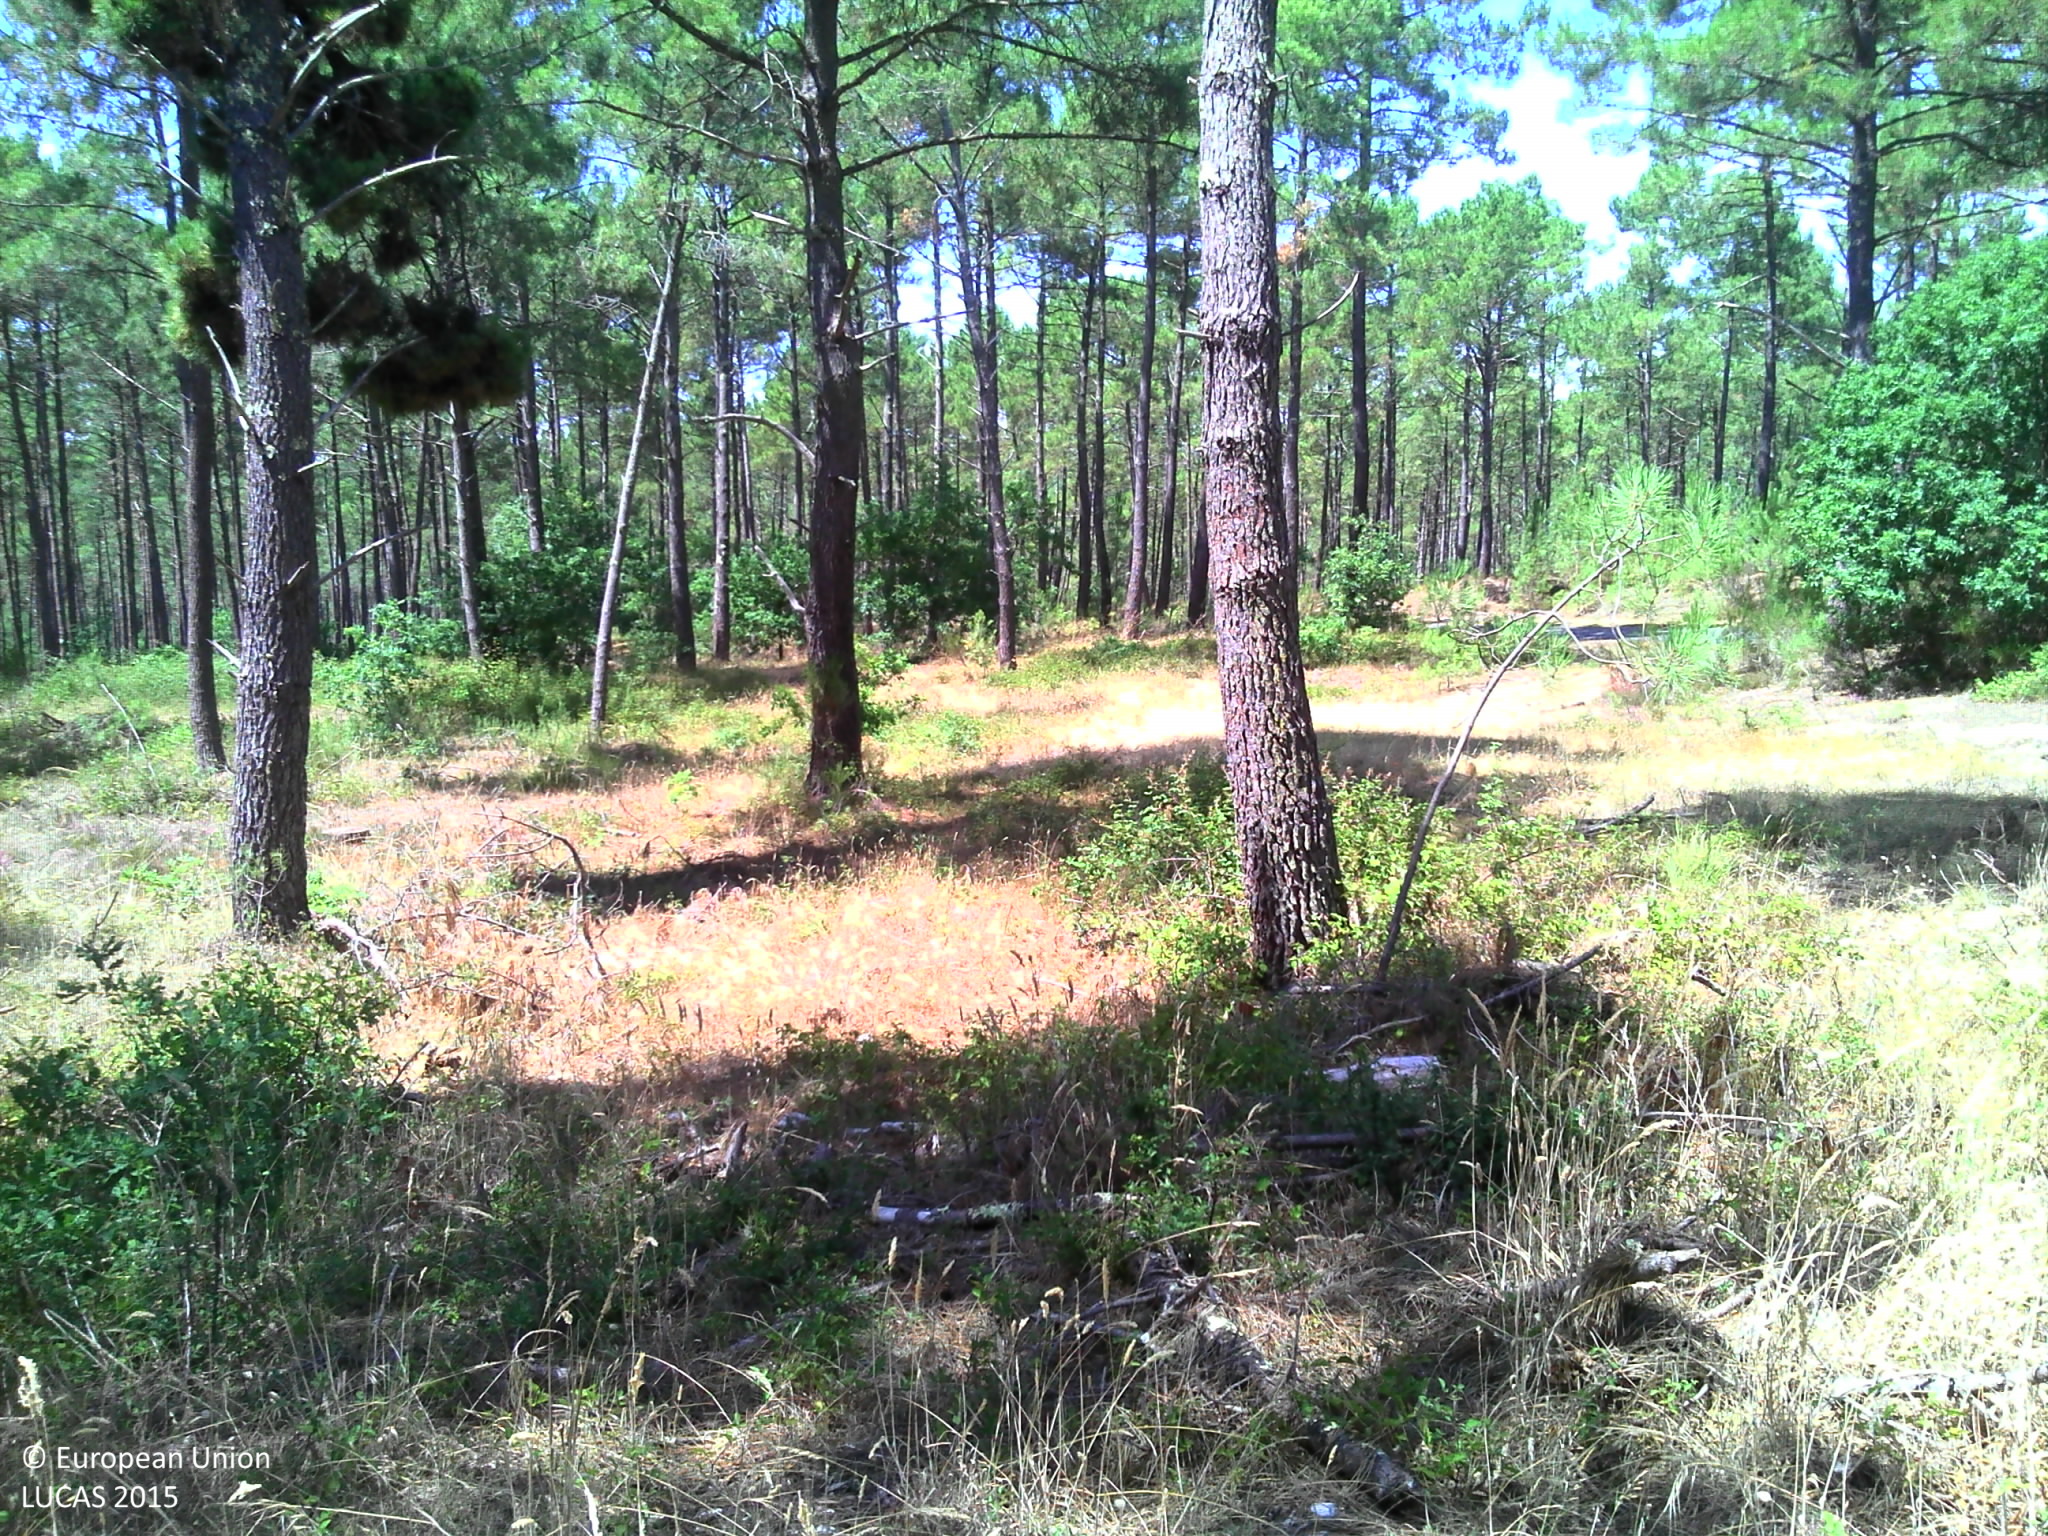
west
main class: Woodland
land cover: Pine dominated coniferous woodland
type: coniferous forest of the mediterranean region
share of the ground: > 75 %
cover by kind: coniferous forest trees 85 %, shrubs 10 %, herbaceous plants 5 %
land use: Forestry
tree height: > 5 m
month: July
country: FR
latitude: 44.1335
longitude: -1.2825
